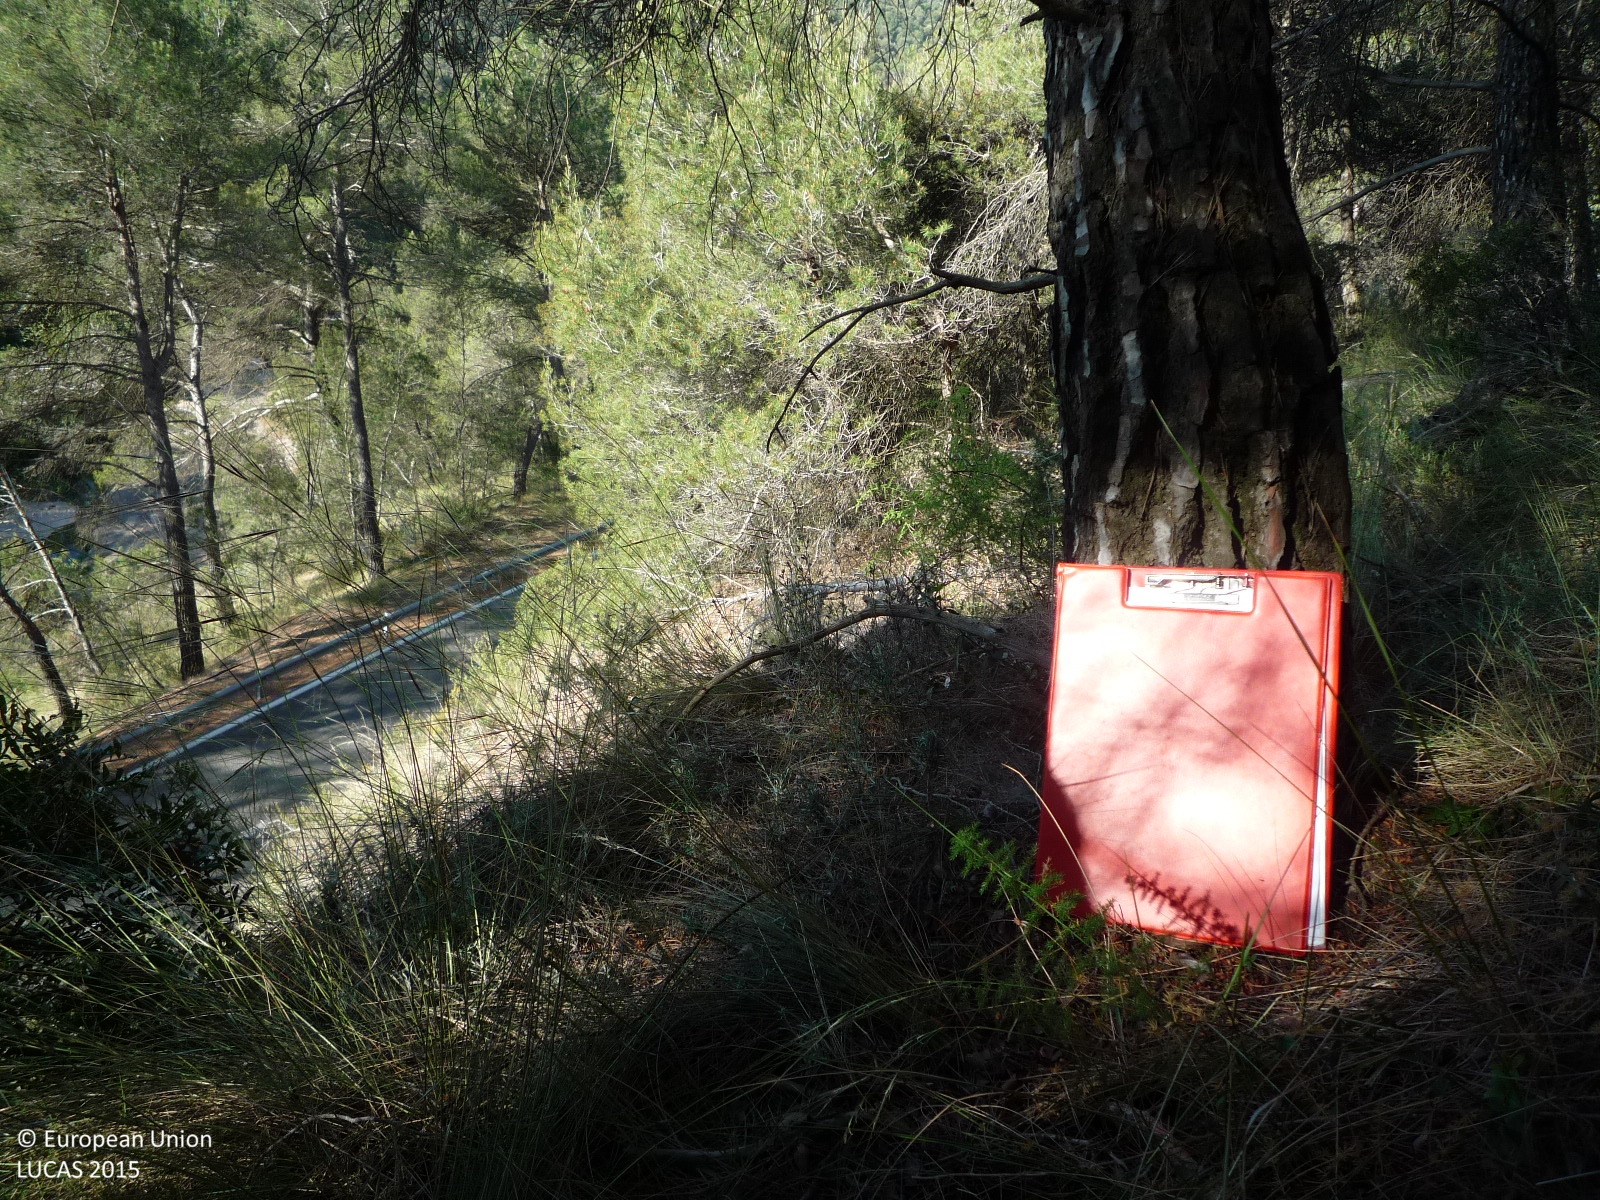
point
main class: Woodland
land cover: Pine dominated coniferous woodland
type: coniferous forest of the mediterranean region
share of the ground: > 75 %
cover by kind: coniferous forest trees 95 %, herbaceous plants 5 %
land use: Semi-natural and natural areas not in use
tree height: > 5 m
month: May
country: ES
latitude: 41.6700
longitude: 2.0528
